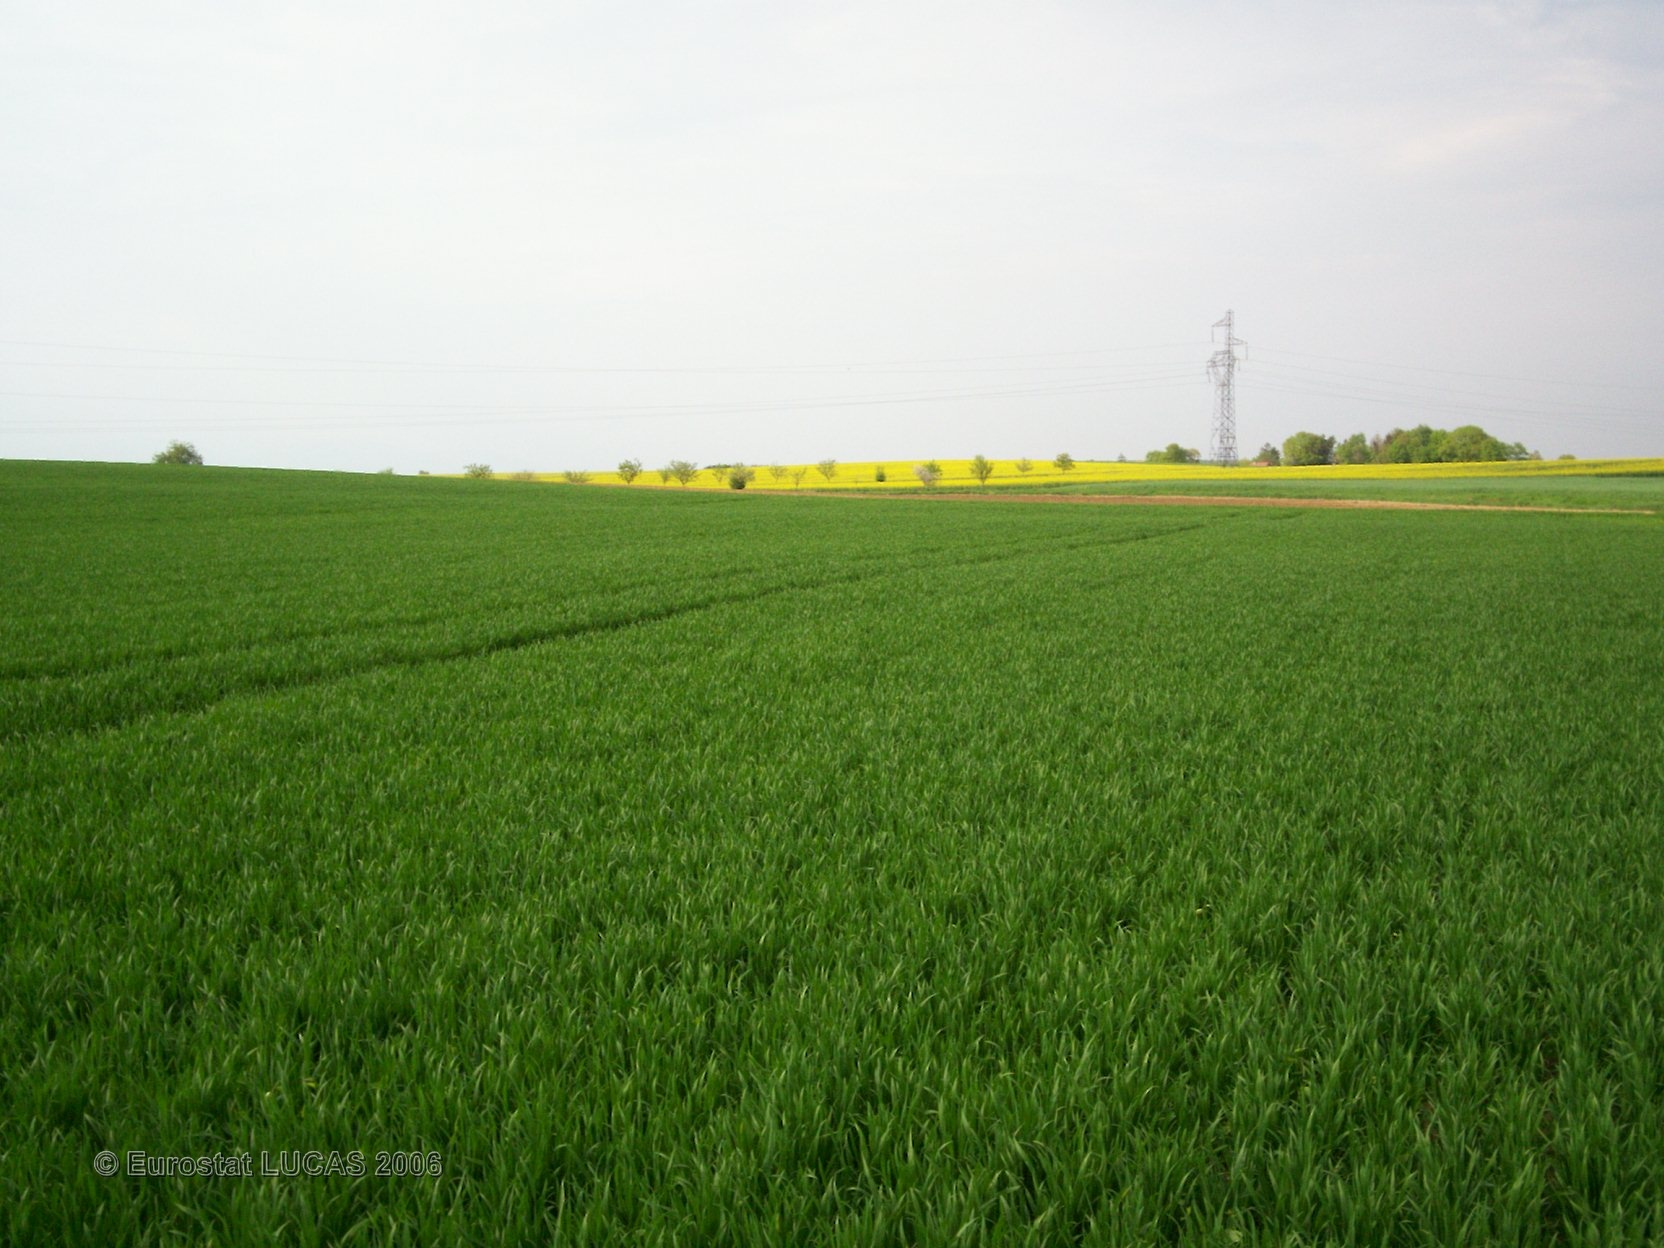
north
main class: Cropland
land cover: Common wheat
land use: Agriculture (excluding fallow land and kitchen gardens)
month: May
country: FR
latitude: 47.5736
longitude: 7.1169
